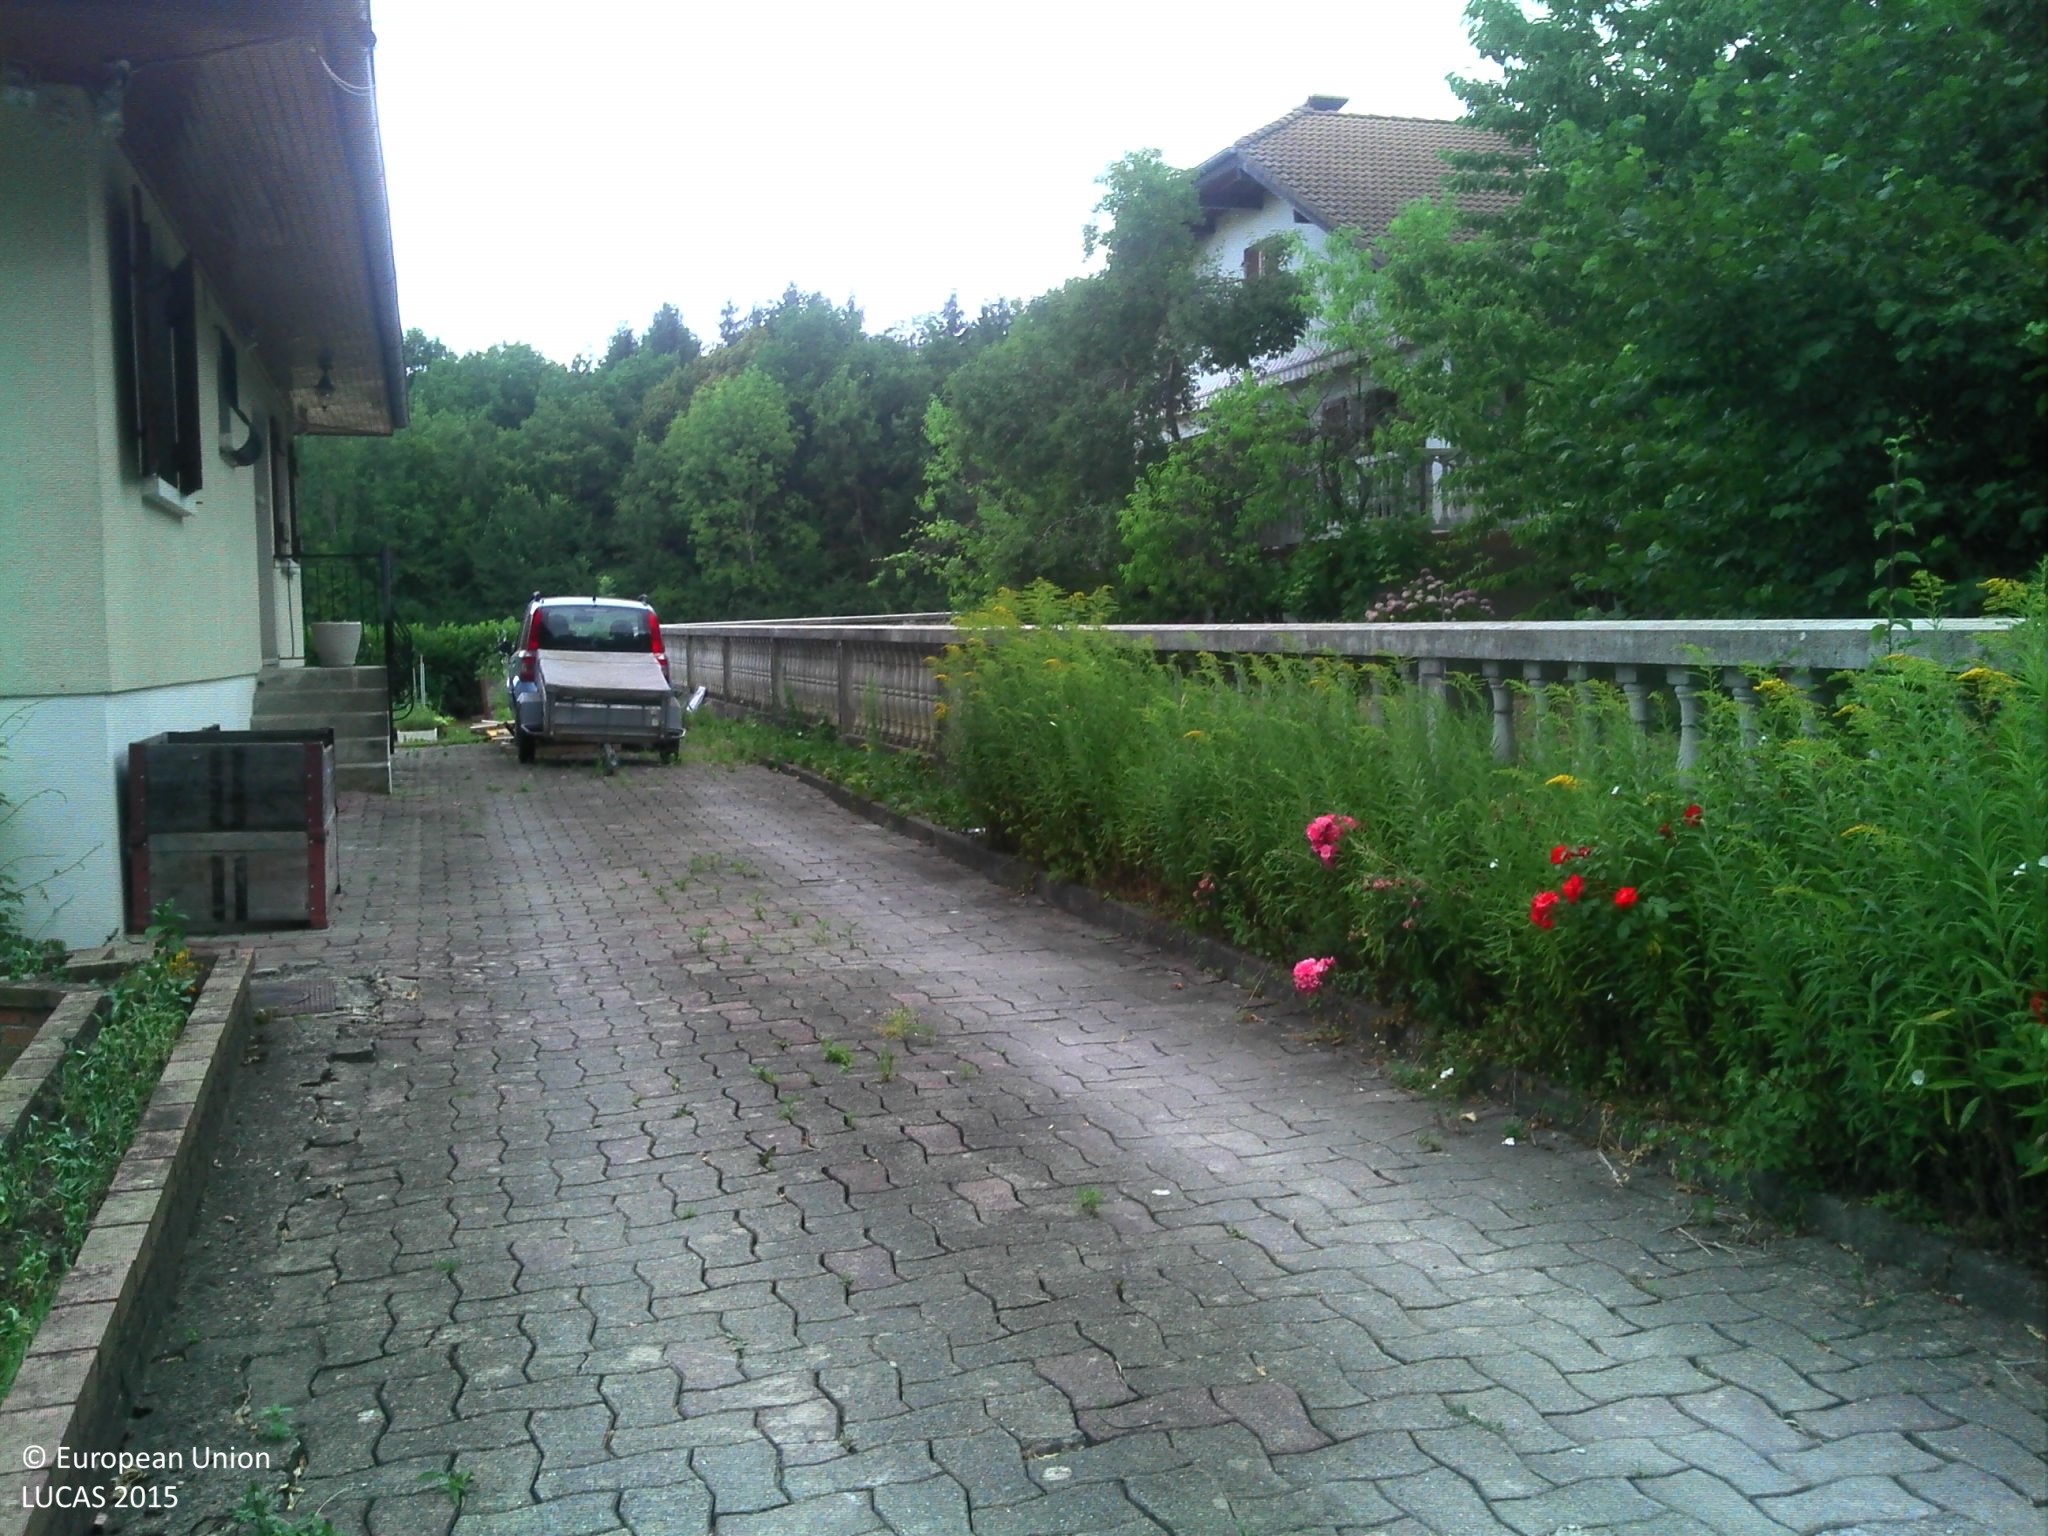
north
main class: Grassland
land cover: Grassland with sparse tree/shrub cover
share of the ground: > 75 %
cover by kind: herbaceous plants 95 %, broadleaved forest trees 5 %
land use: Residential
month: July
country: FR
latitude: 46.1606
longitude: 6.2869
